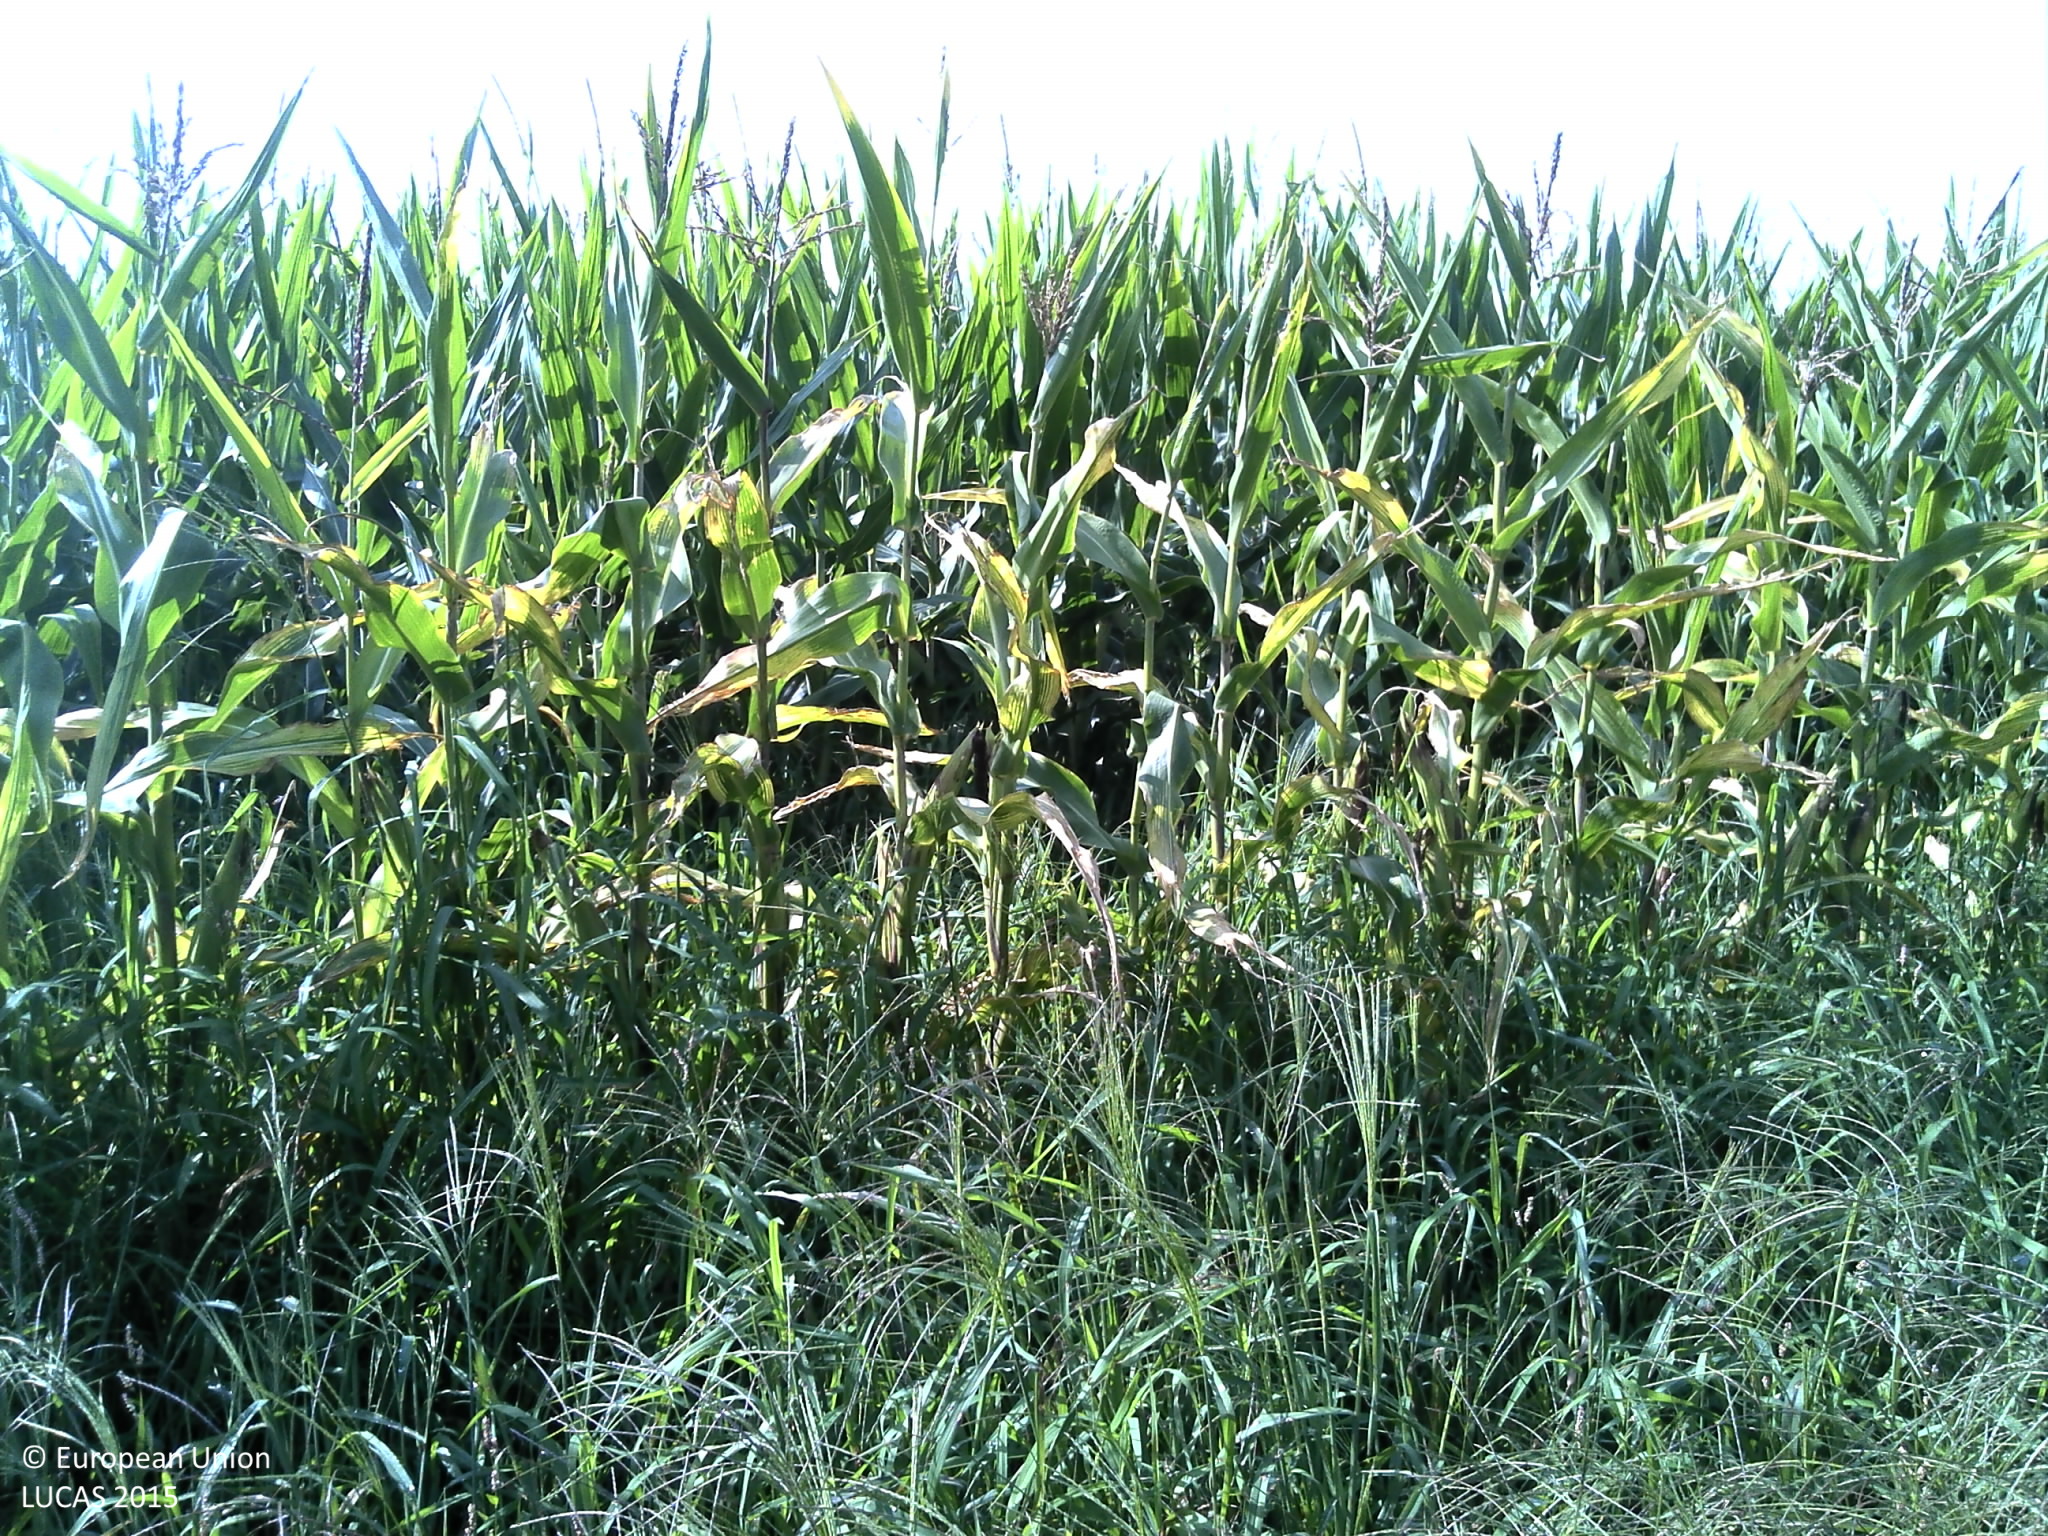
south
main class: Cropland
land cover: Maize
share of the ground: > 75 %
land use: Agriculture (excluding fallow land and kitchen gardens)
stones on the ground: < 10 %
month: August
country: FR
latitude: 44.3421
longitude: -0.5135
